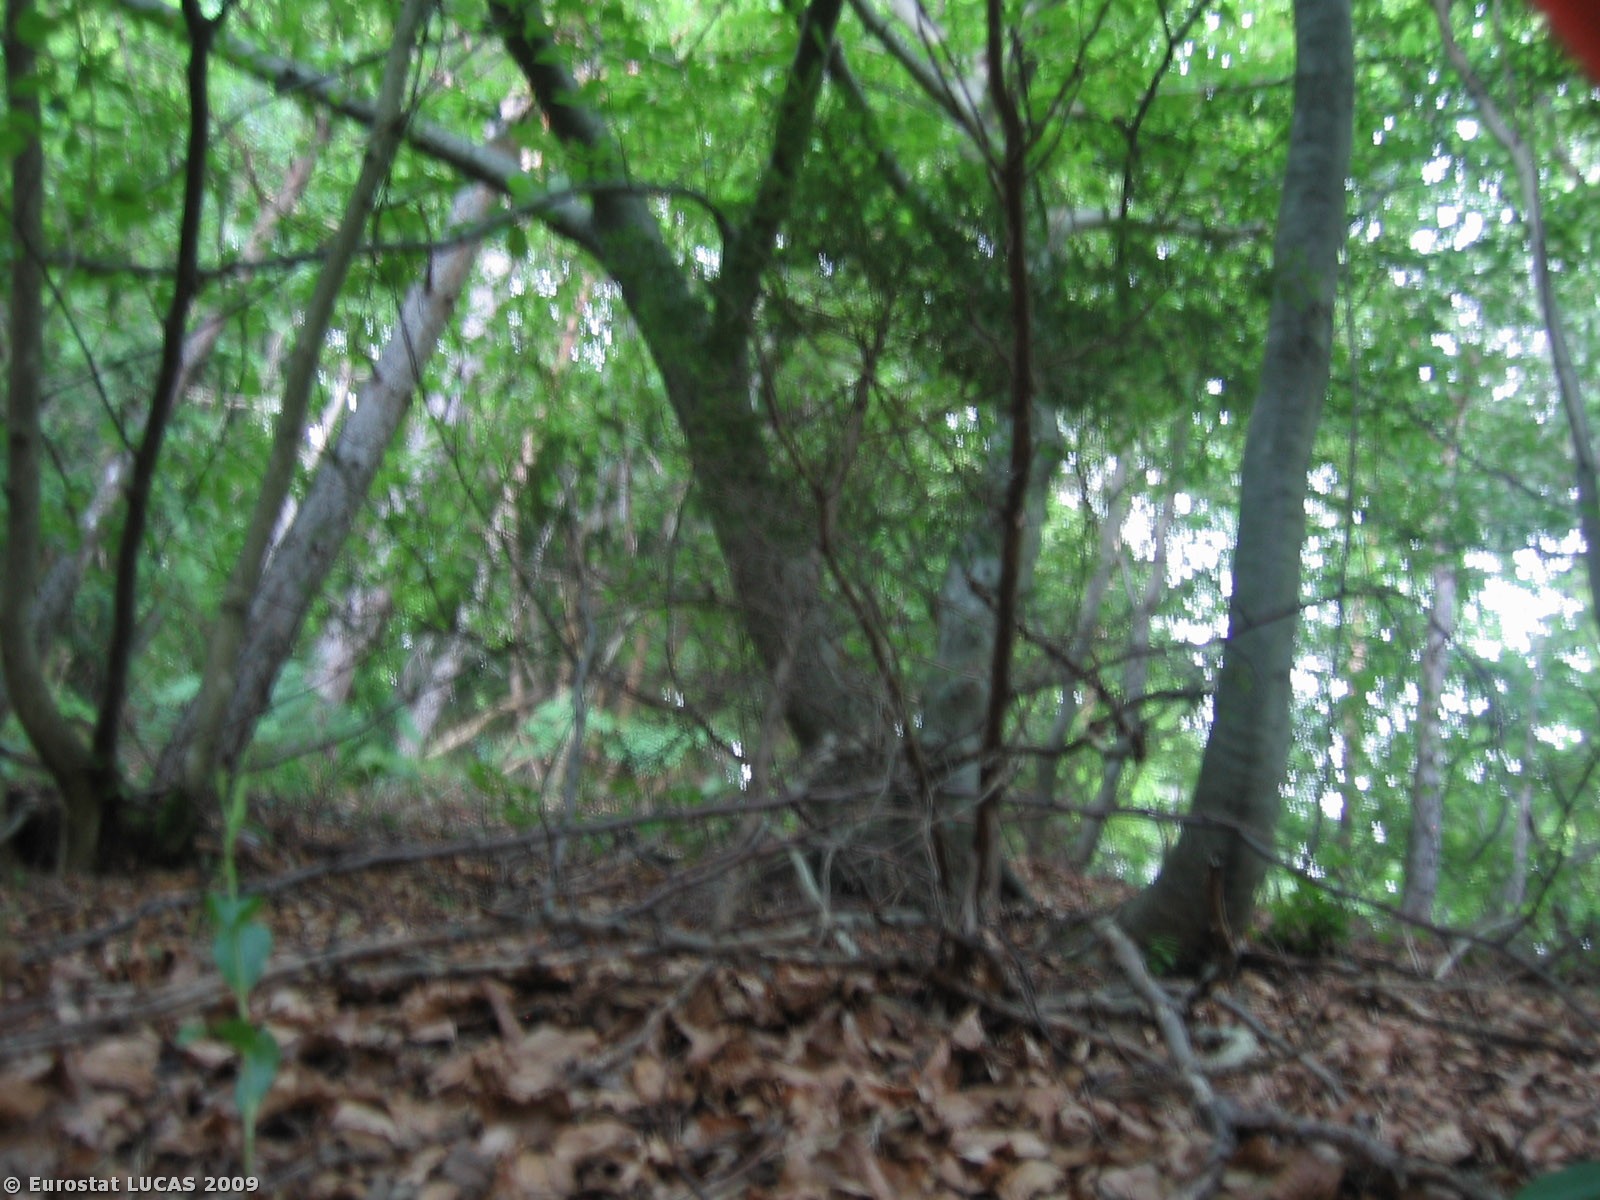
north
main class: Woodland
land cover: Mixed woodland
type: mountainous beech forest
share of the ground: > 75 %
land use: Forestry
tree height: > 5 m
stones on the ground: < 10 %
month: June
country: SI
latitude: 46.0822
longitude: 14.3544
